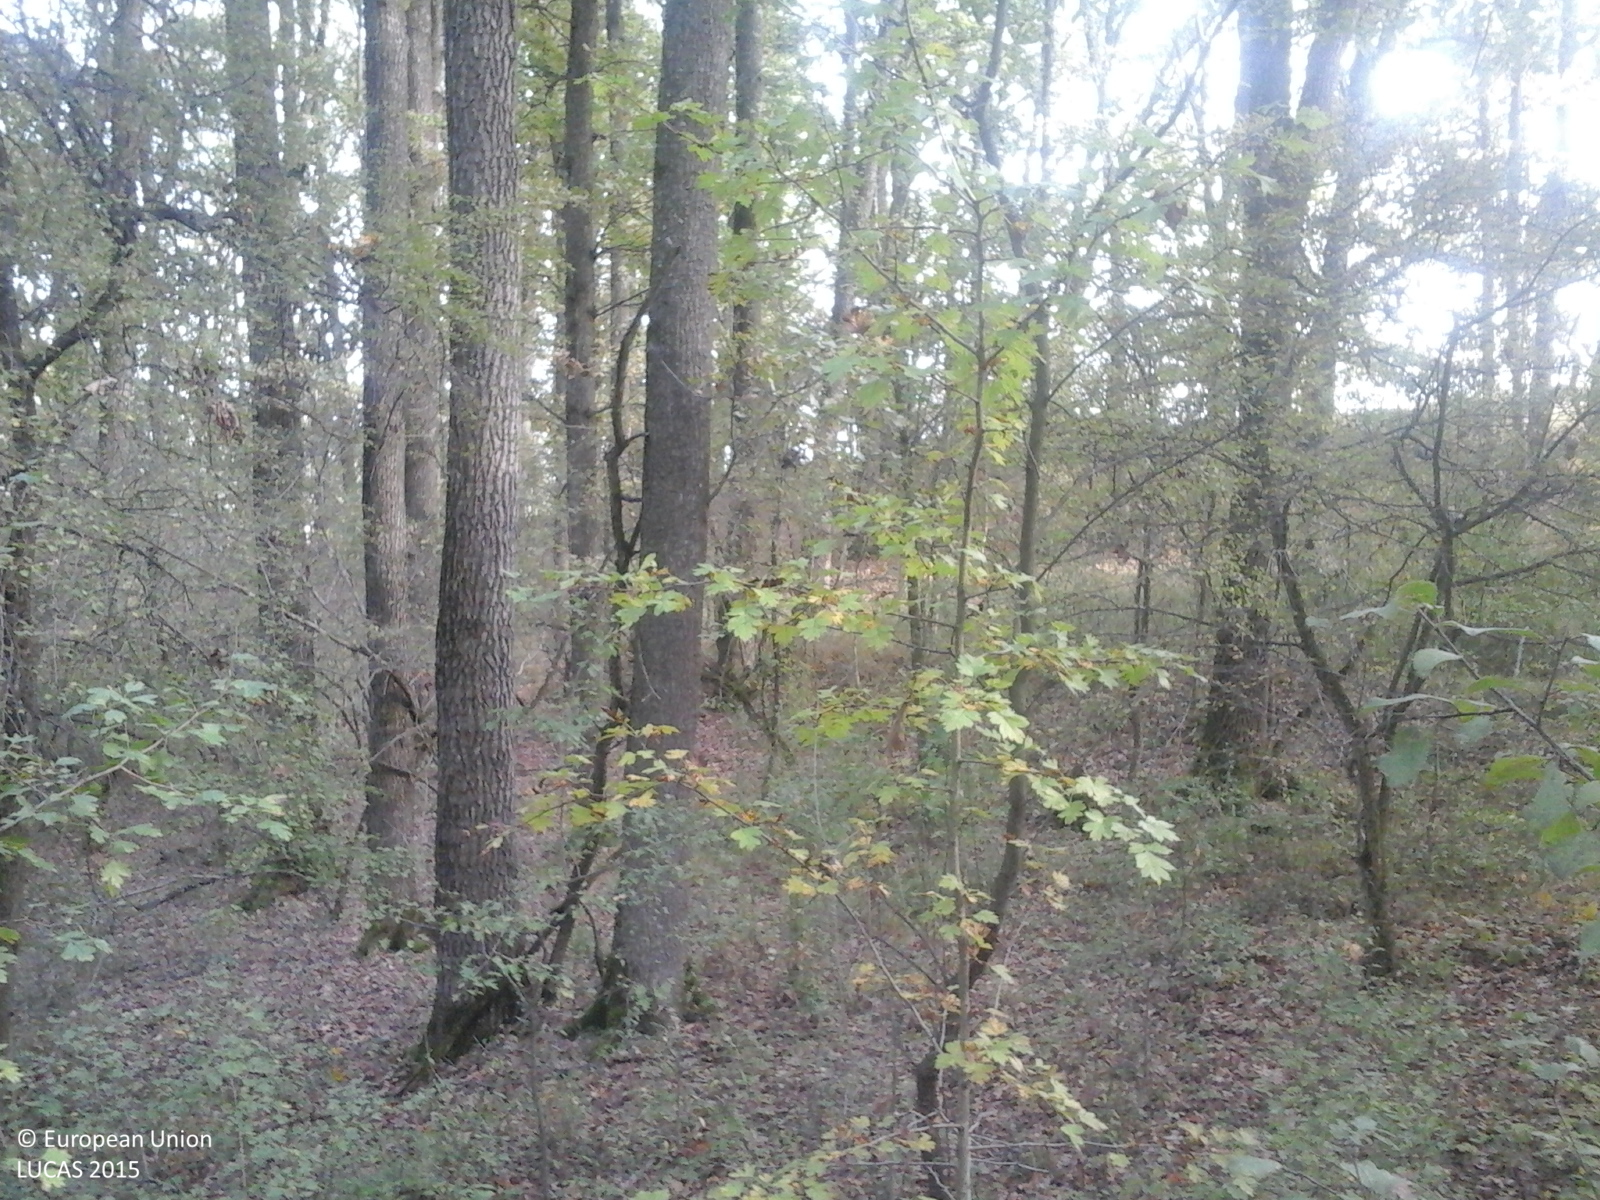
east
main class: Woodland
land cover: Broadleaved woodland
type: acidophilous oak and oak-birch forest
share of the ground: > 75 %
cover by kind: broadleaved forest trees 100 %
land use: Forestry
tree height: > 5 m
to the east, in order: Broadleaved woodland; Grassland with sparse tree/shrub cover; Grassland without tree/shrub cover; Ditches and canals
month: October
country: RO
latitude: 45.8793
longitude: 24.9474
